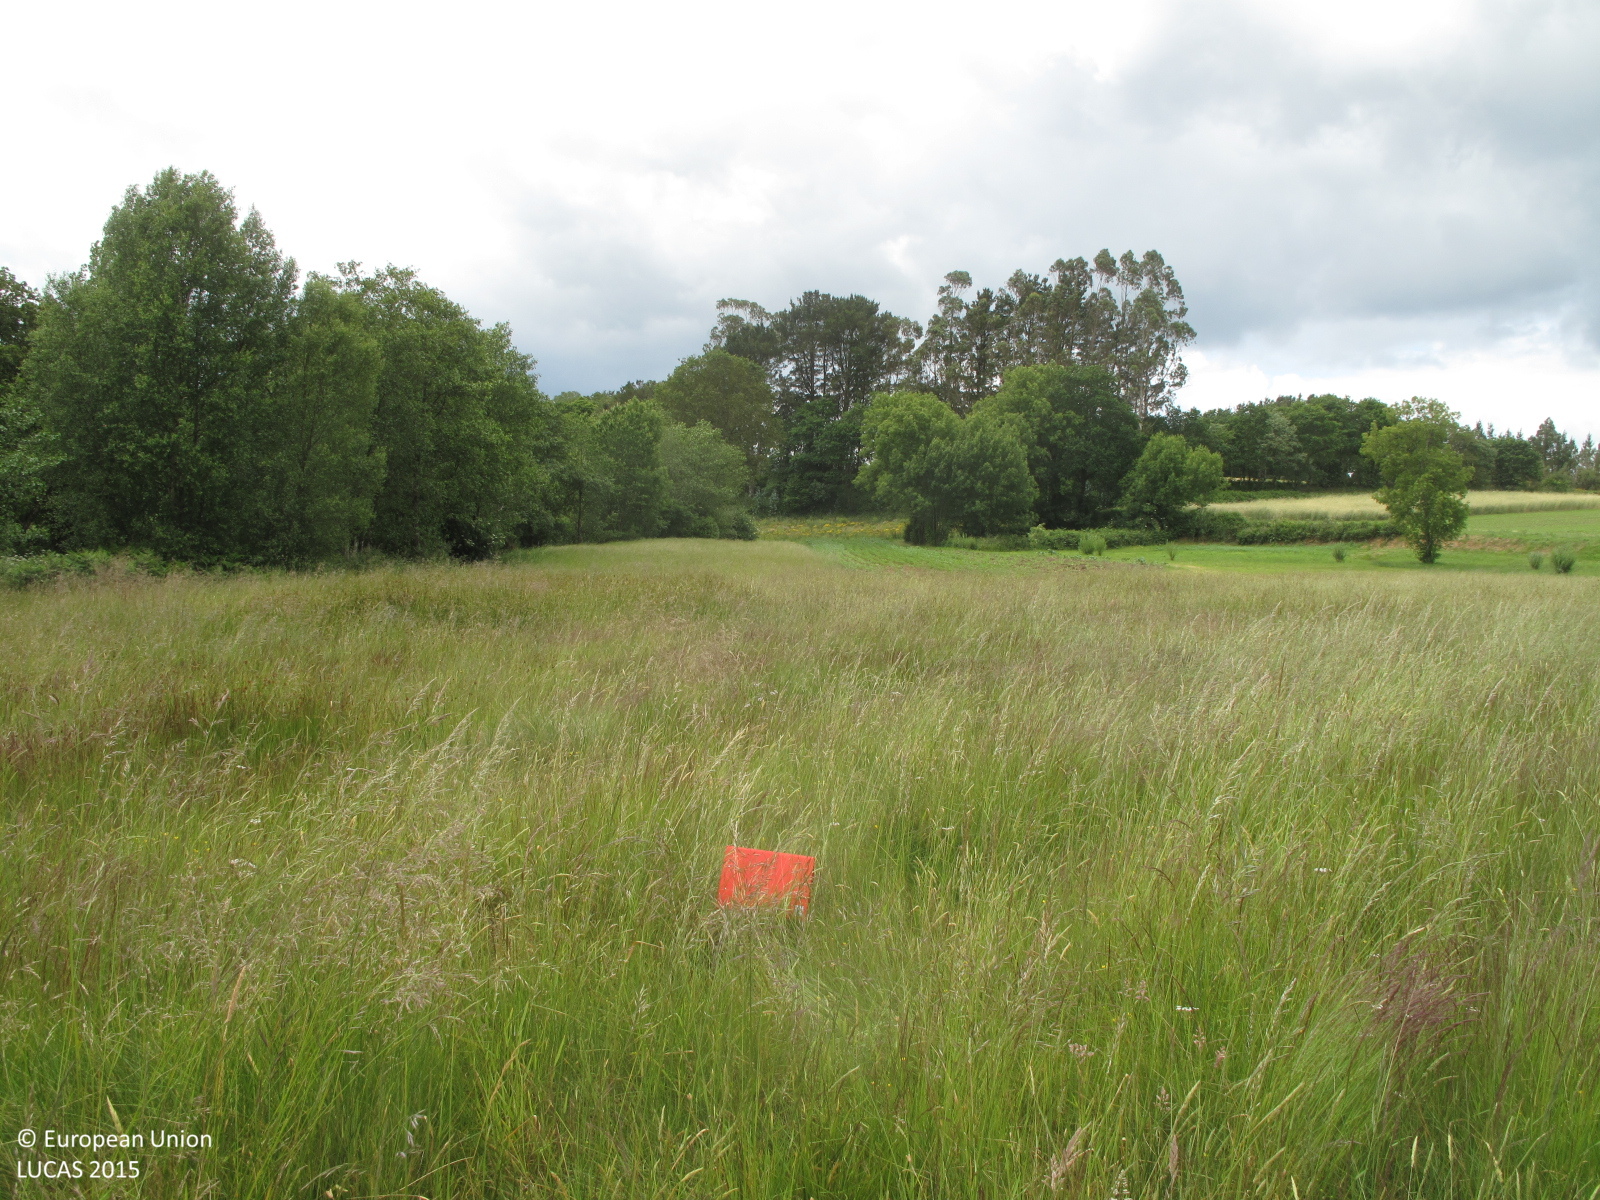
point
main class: Grassland
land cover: Grassland without tree/shrub cover
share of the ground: > 75 %
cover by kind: herbaceous plants 100 %
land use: Agriculture (excluding fallow land and kitchen gardens)
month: June
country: ES
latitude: 43.0855
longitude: -8.5455
